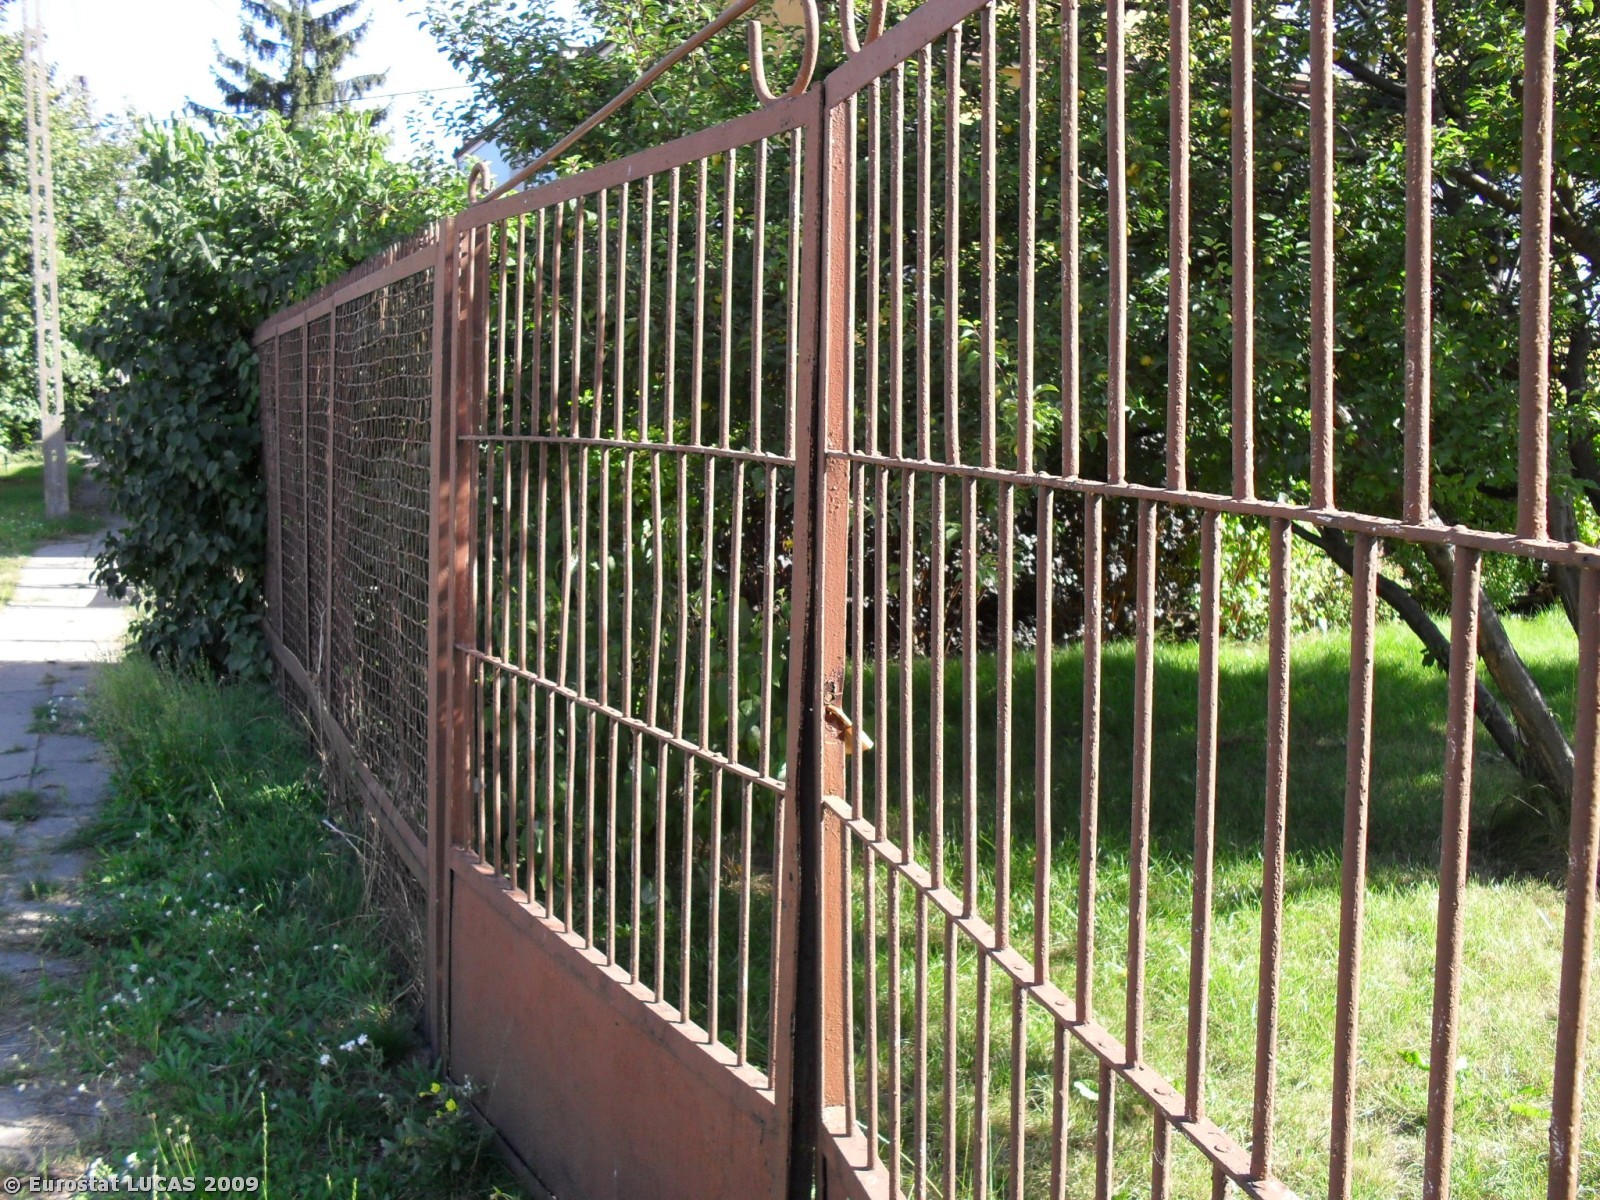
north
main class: Artificial land
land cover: Buildings with 1 to 3 floors
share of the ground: > 75 %
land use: Residential
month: August
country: PL
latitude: 51.7303
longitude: 19.4239
